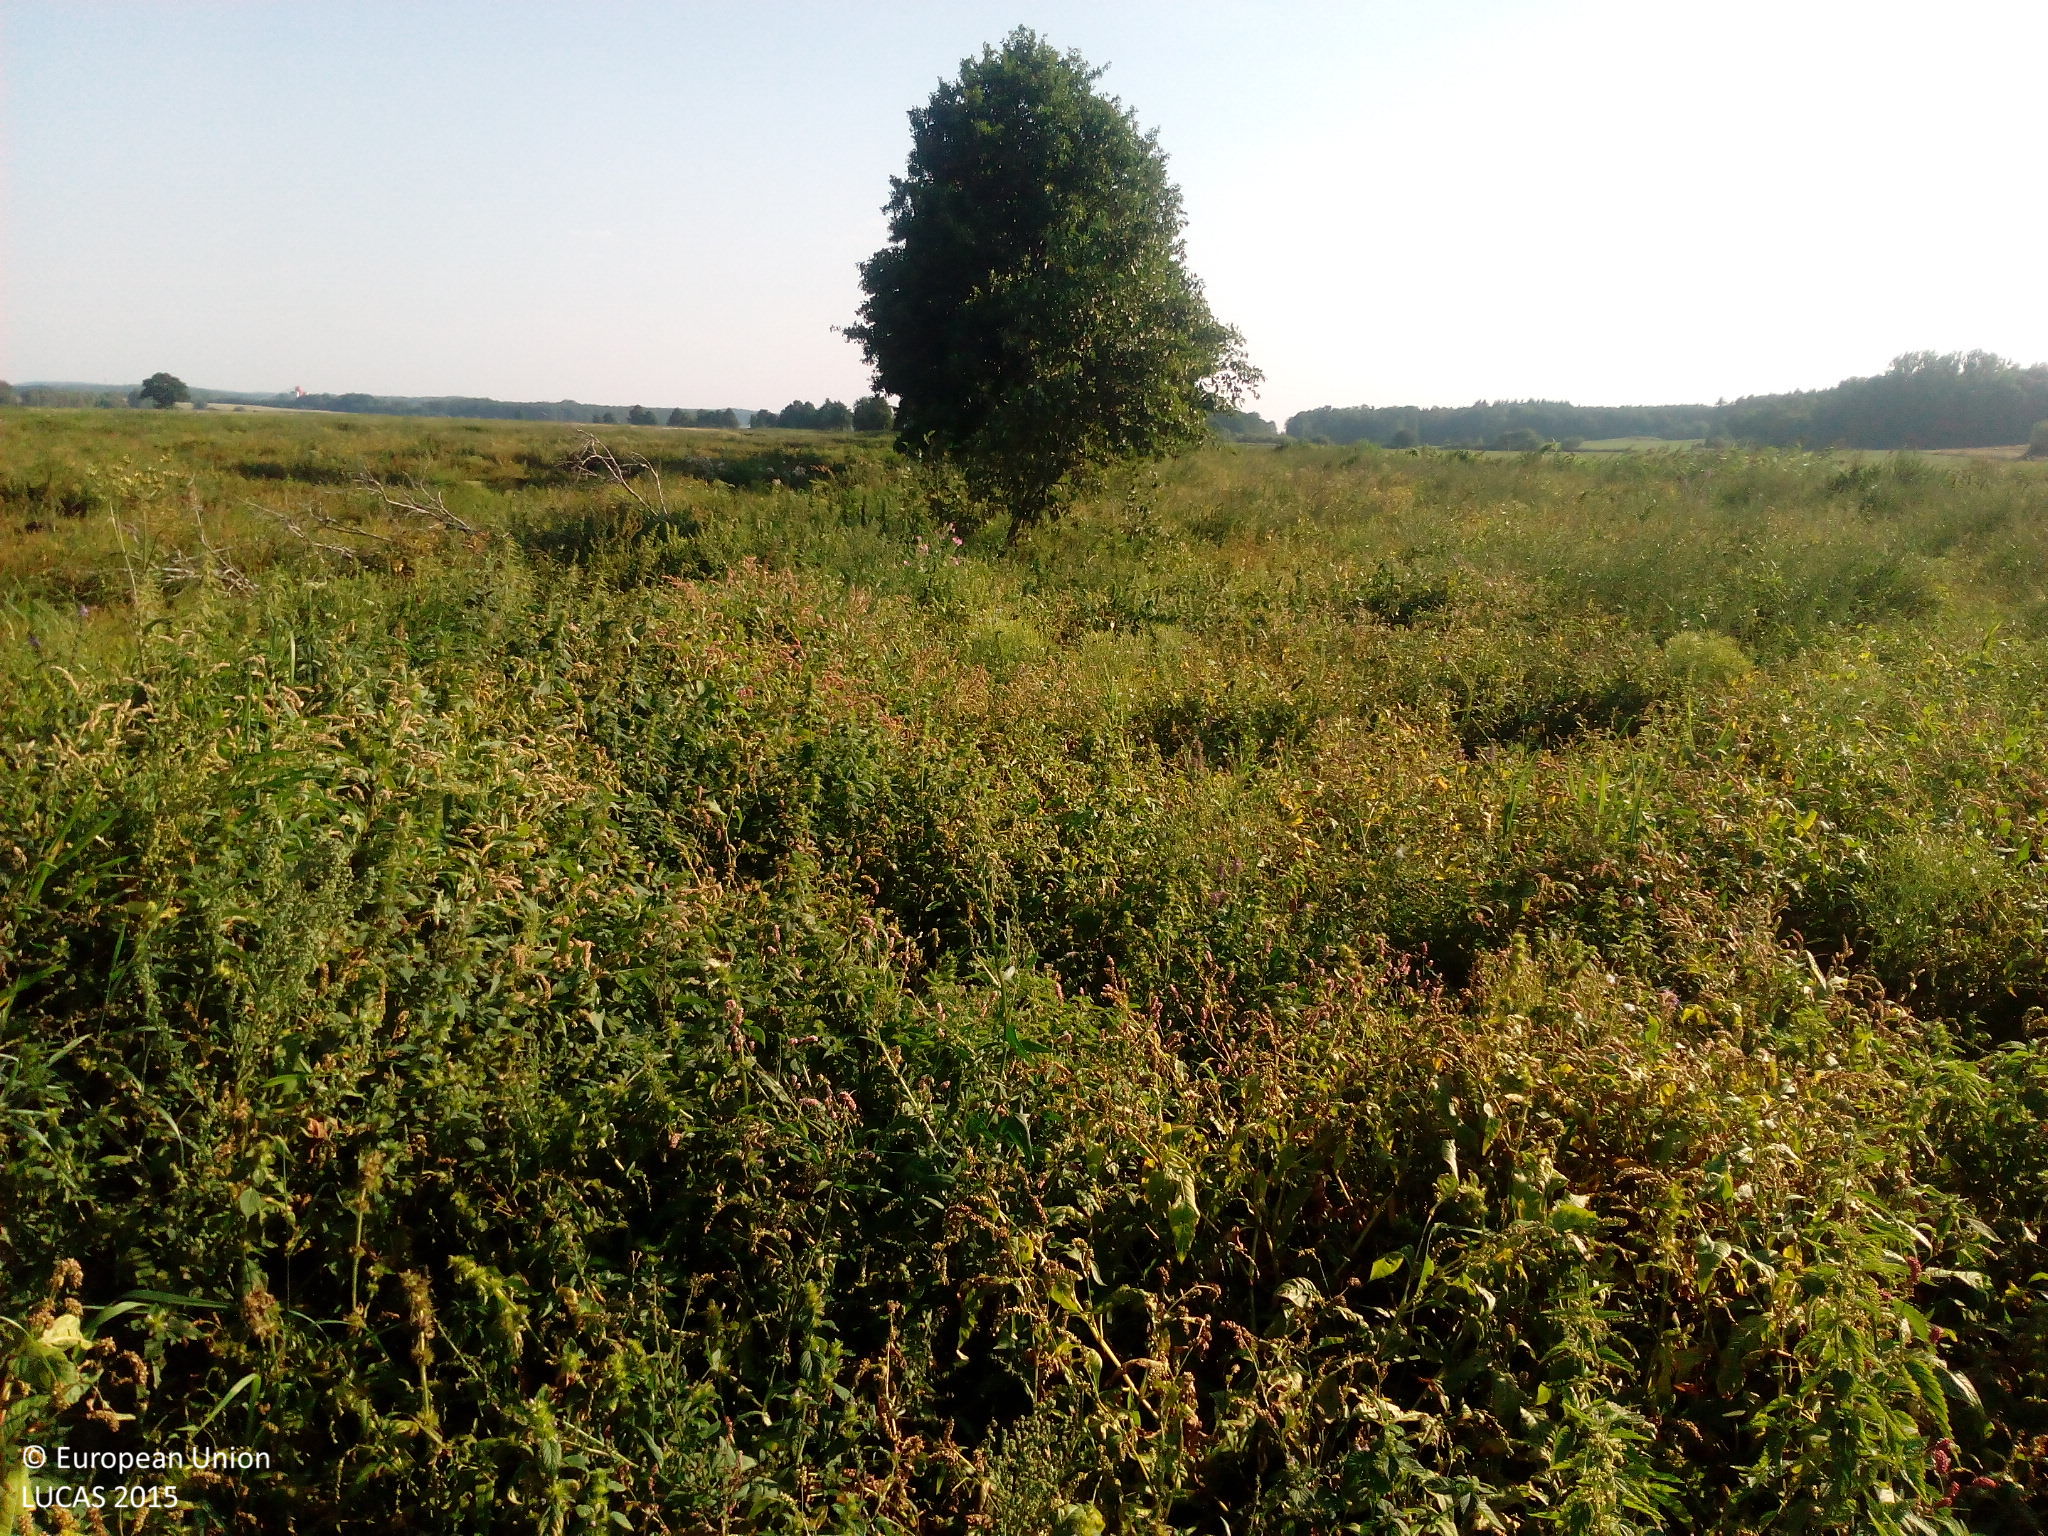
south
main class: Grassland
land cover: Spontaneously vegetated surfaces
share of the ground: > 75 %
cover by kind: herbaceous plants 100 %
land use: Semi-natural and natural areas not in use
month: August
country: DE
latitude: 53.9190
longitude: 12.3287
